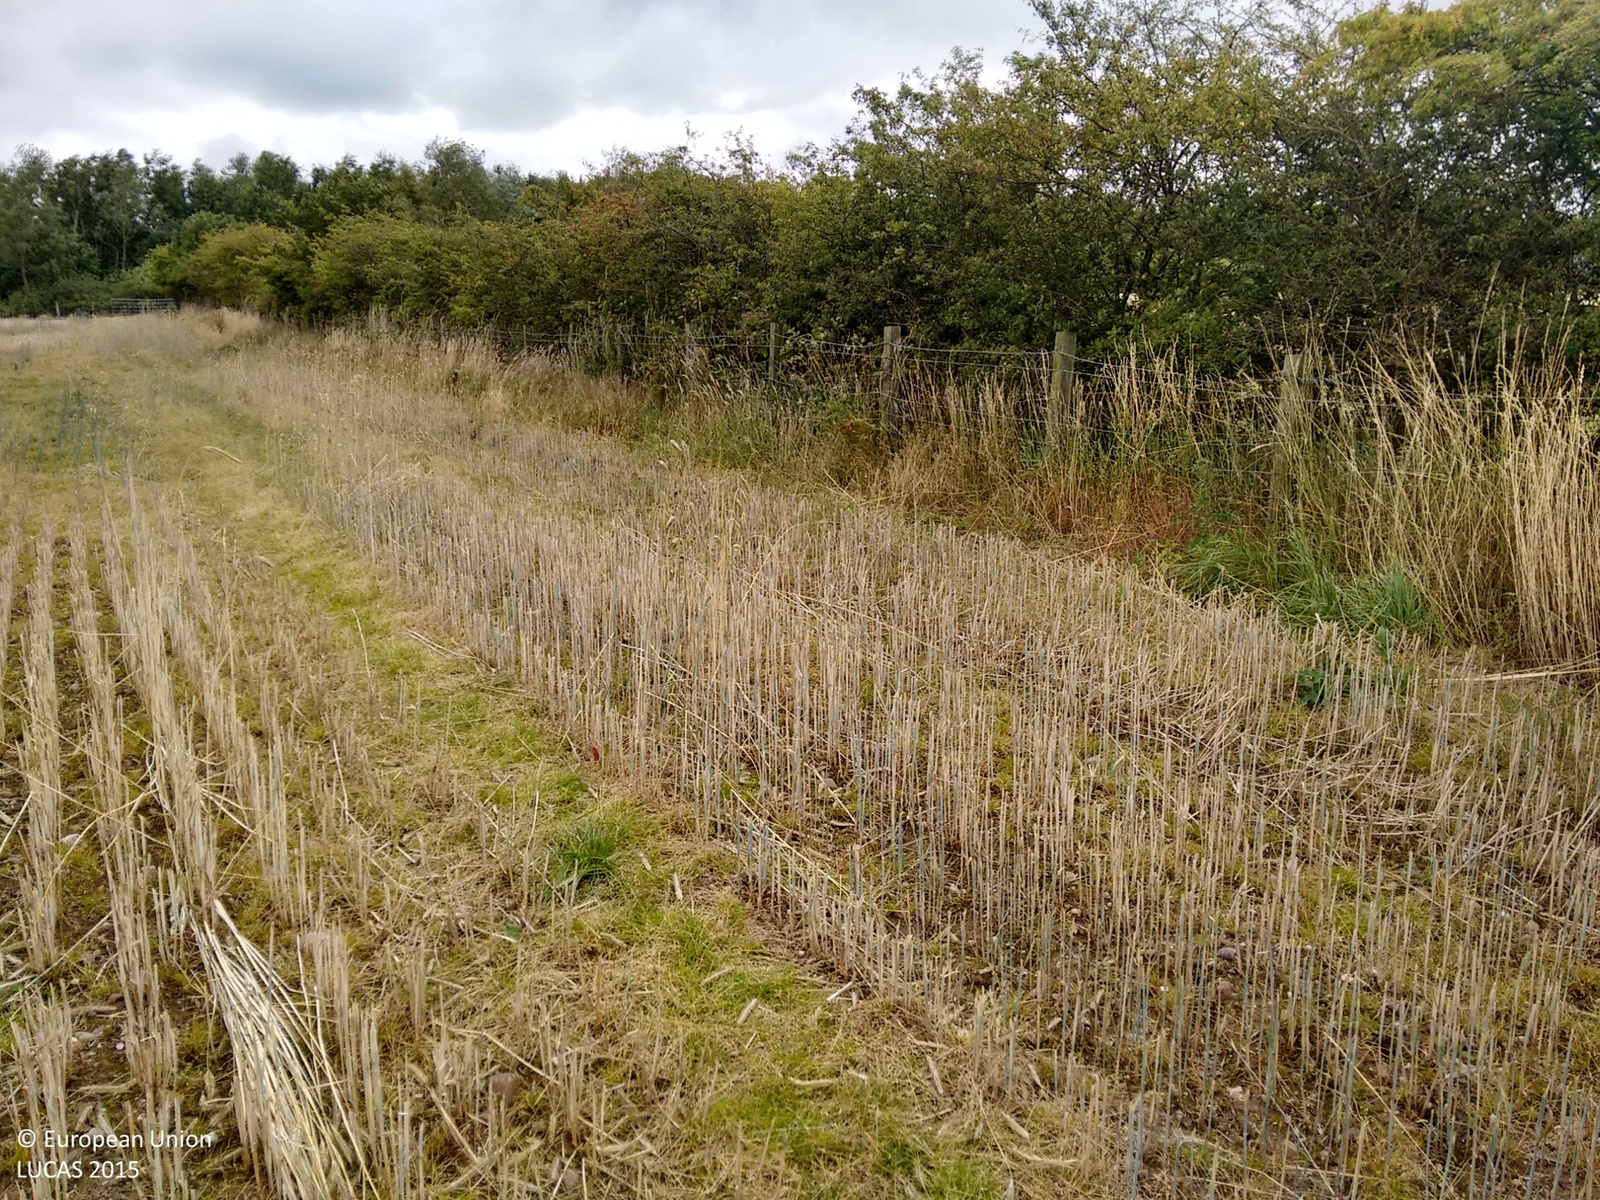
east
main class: Cropland
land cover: Common wheat
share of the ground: 10 - 25 %
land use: Agriculture (excluding fallow land and kitchen gardens)
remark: Harvested field
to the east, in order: Common wheat; Fences; Managed hedges; Fences; Common wheat; Grass margins; Fences; Broadleaved woodland; Fences; Grassland without tree/shrub cover
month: July
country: GB
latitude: 52.6759
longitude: -1.9936
